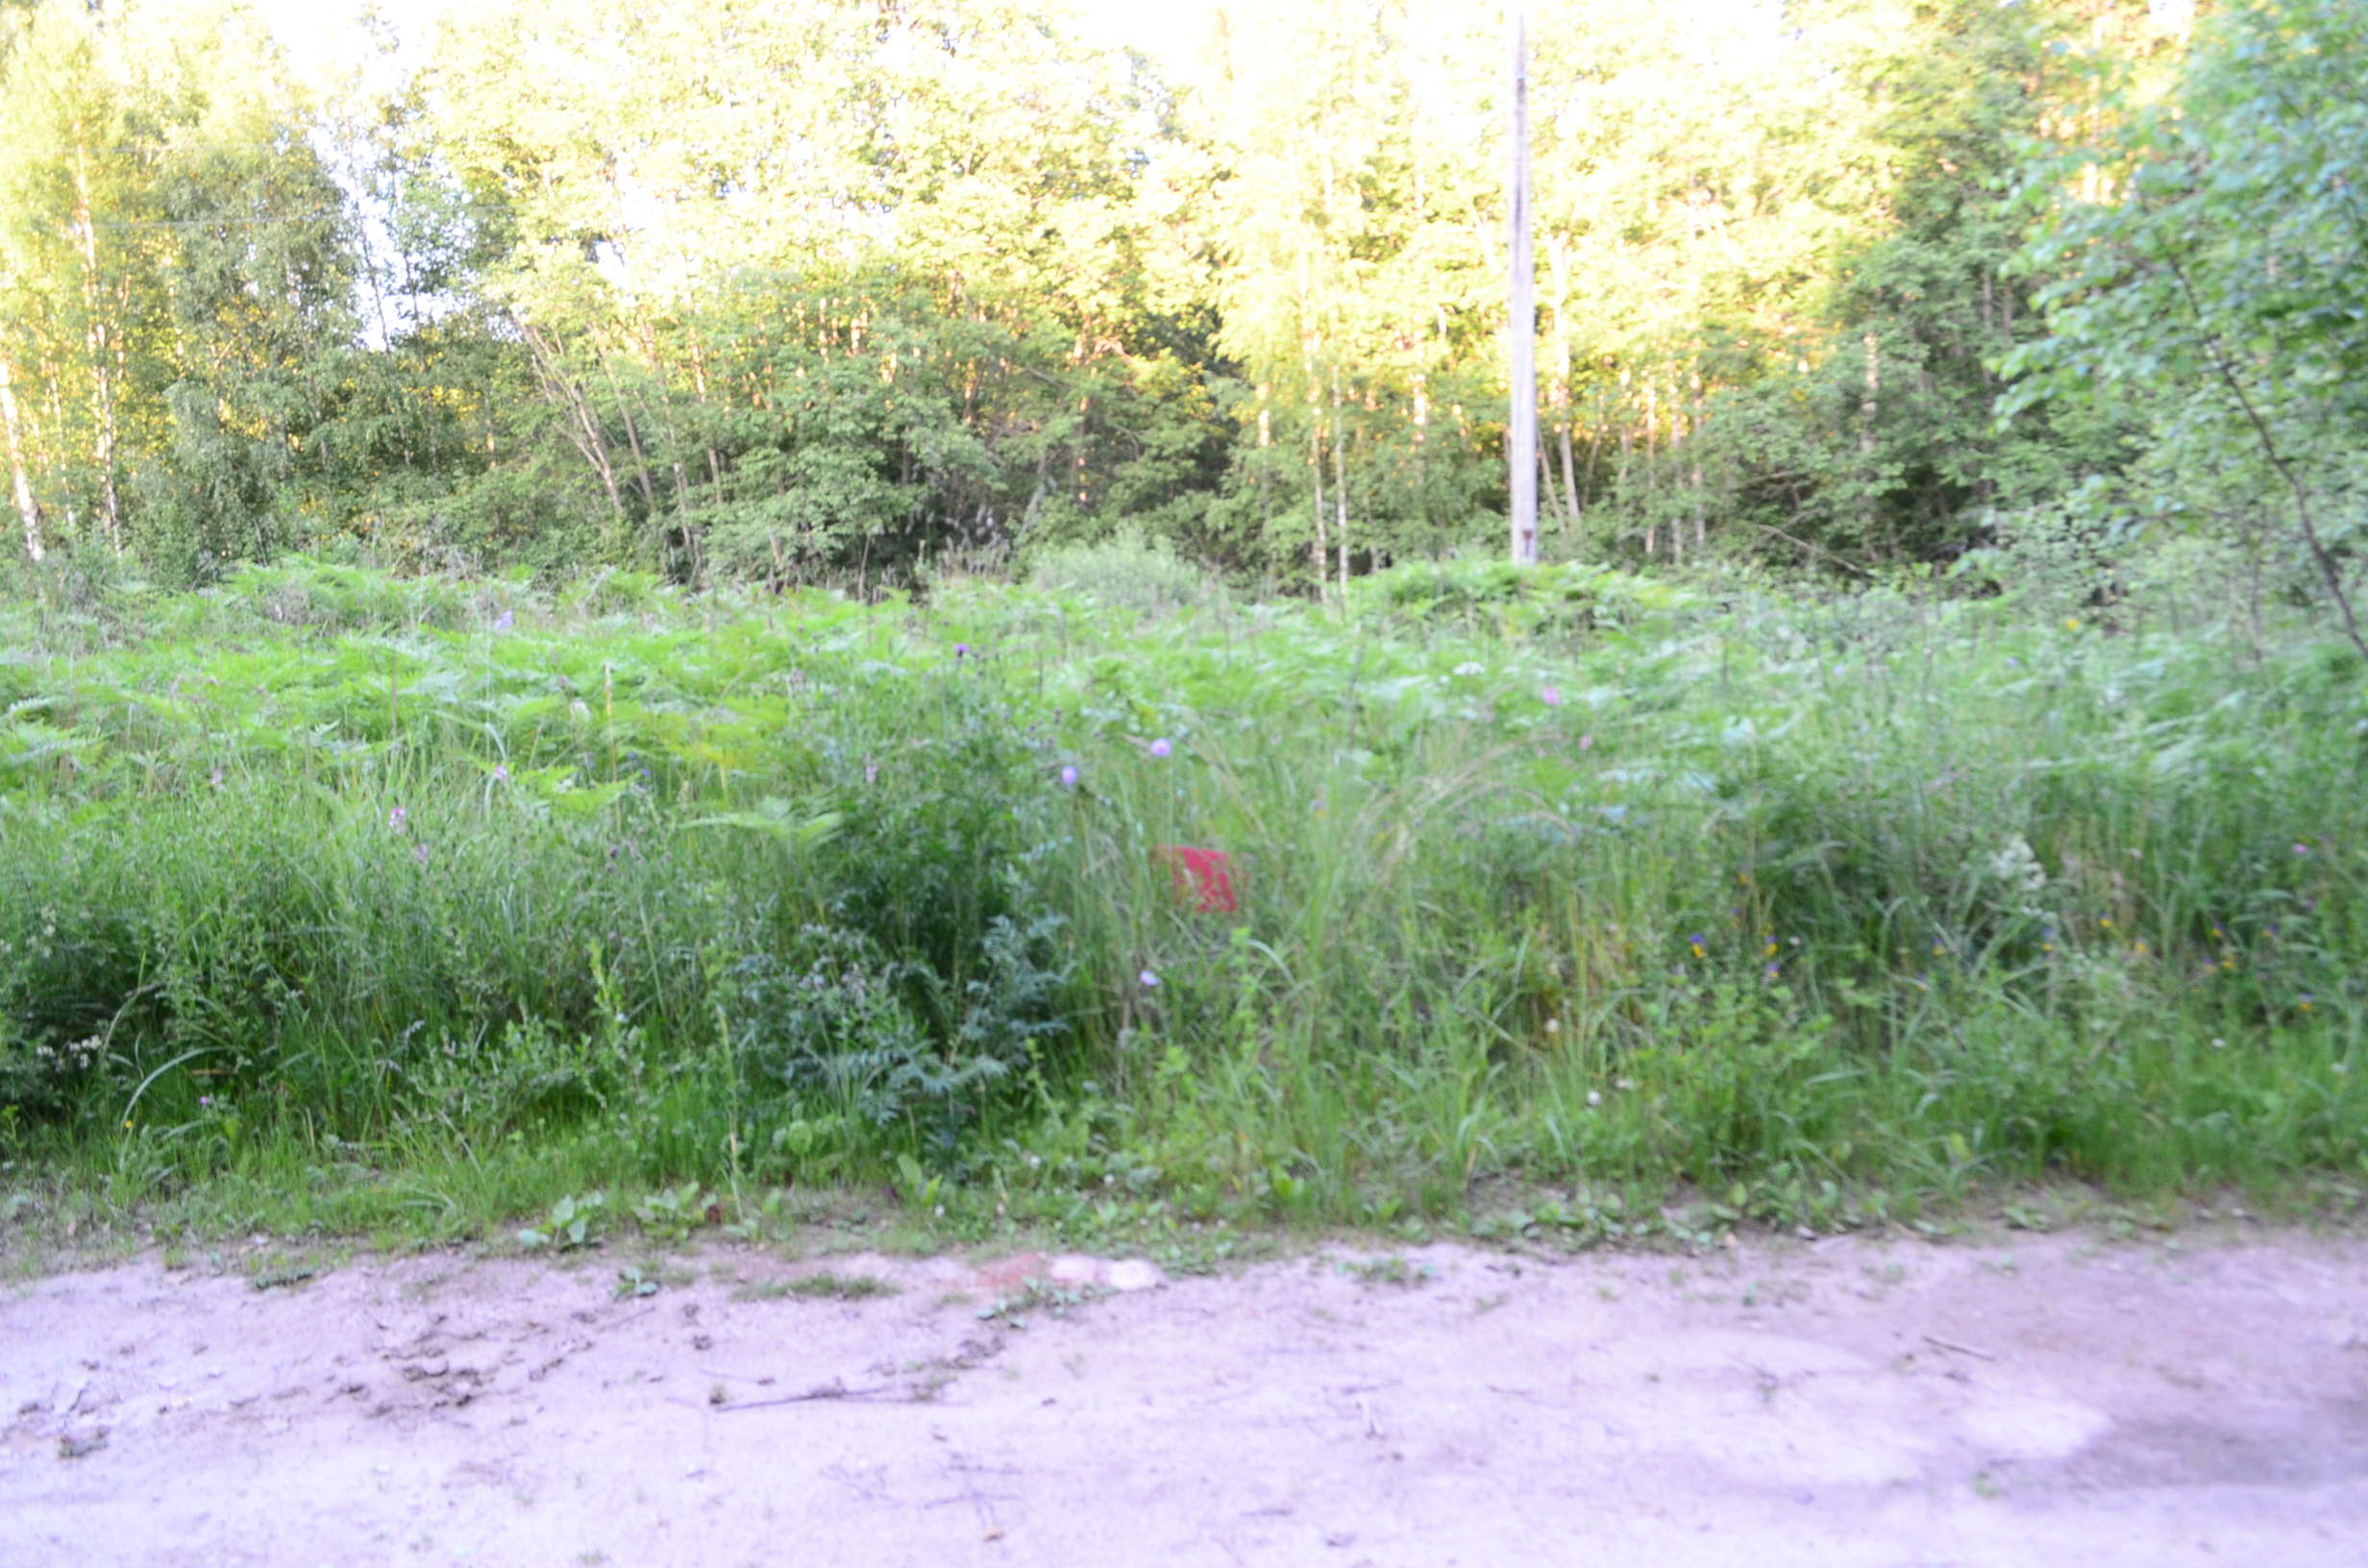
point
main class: Grassland
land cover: Grassland with sparse tree/shrub cover
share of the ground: > 75 %
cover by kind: herbaceous plants 95 %, broadleaved forest trees 5 %
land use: Semi-natural and natural areas not in use
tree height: < 5 m
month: July
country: LV
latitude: 57.0973
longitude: 22.3826
